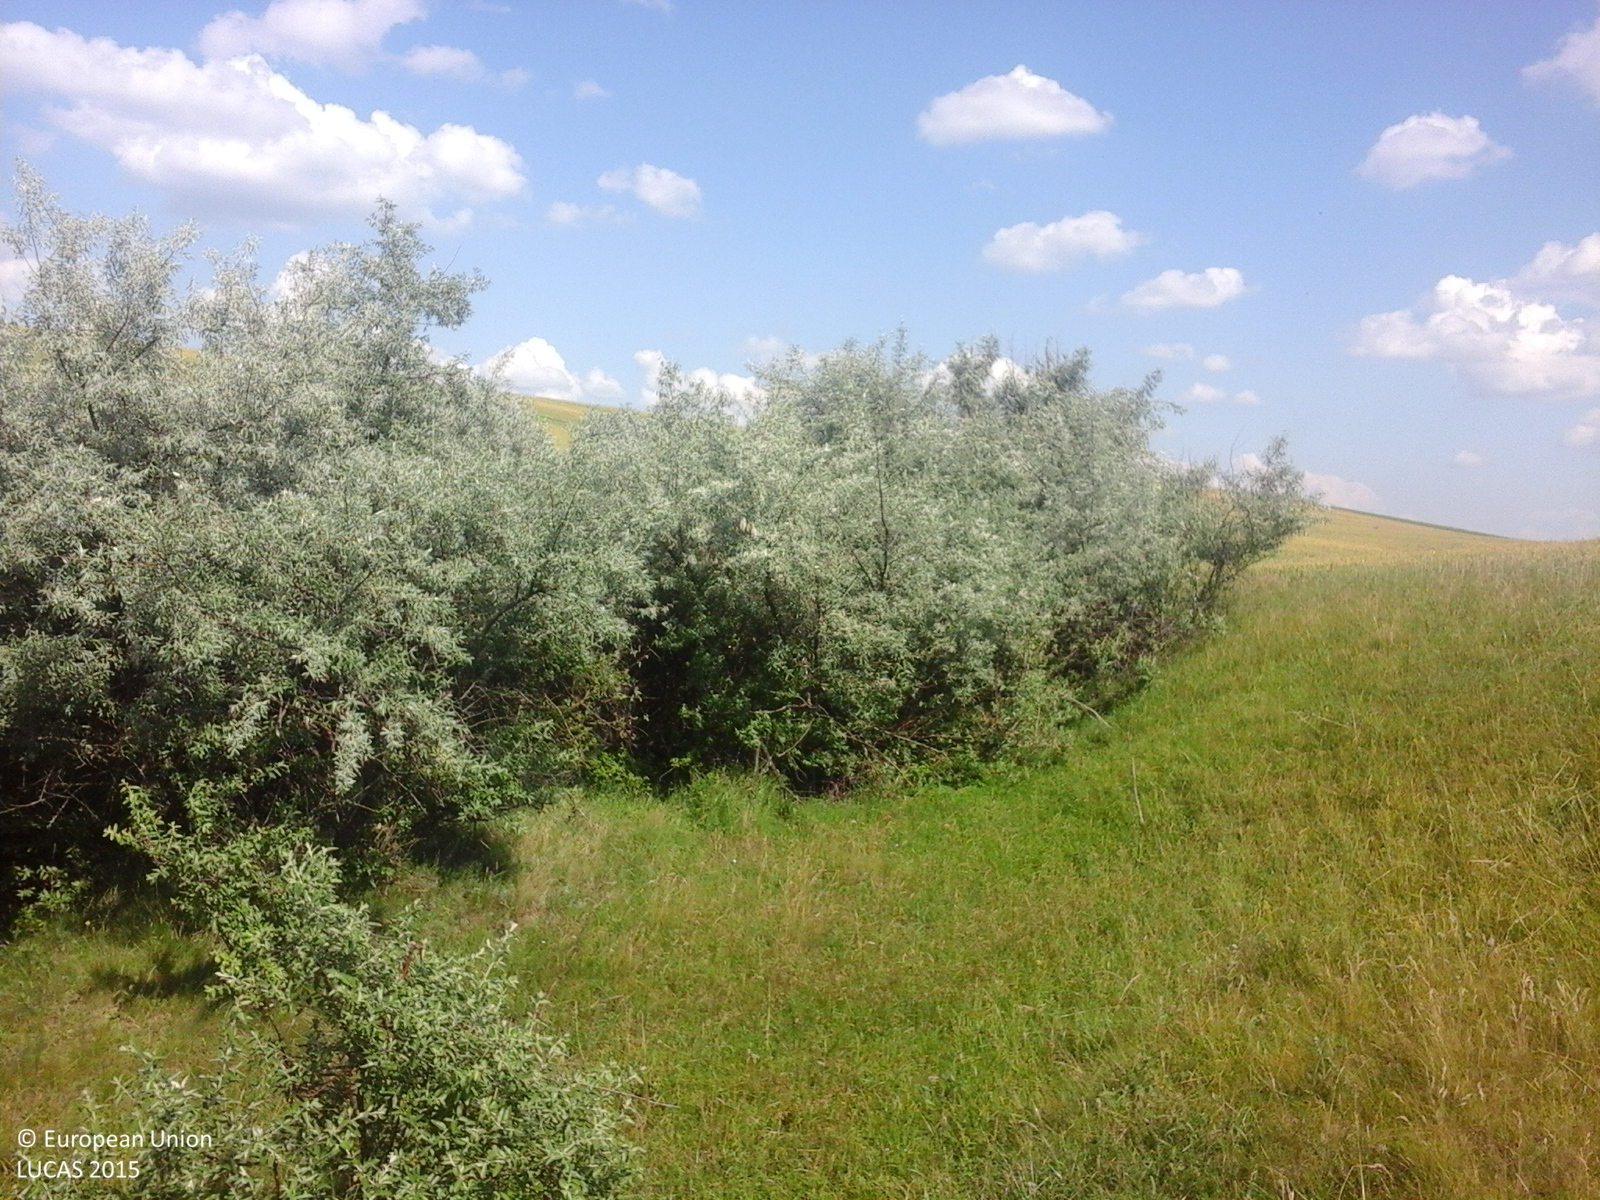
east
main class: Grassland
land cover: Grassland with sparse tree/shrub cover
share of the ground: > 75 %
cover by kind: herbaceous plants 85 %, shrubs 10 %, broadleaved forest trees 5 %
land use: Agriculture (excluding fallow land and kitchen gardens)
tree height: < 5 m
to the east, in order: Grassland with sparse tree/shrub cover; Shrubland without tree cover; Common wheat
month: June
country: RO
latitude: 48.1719
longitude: 26.6785
